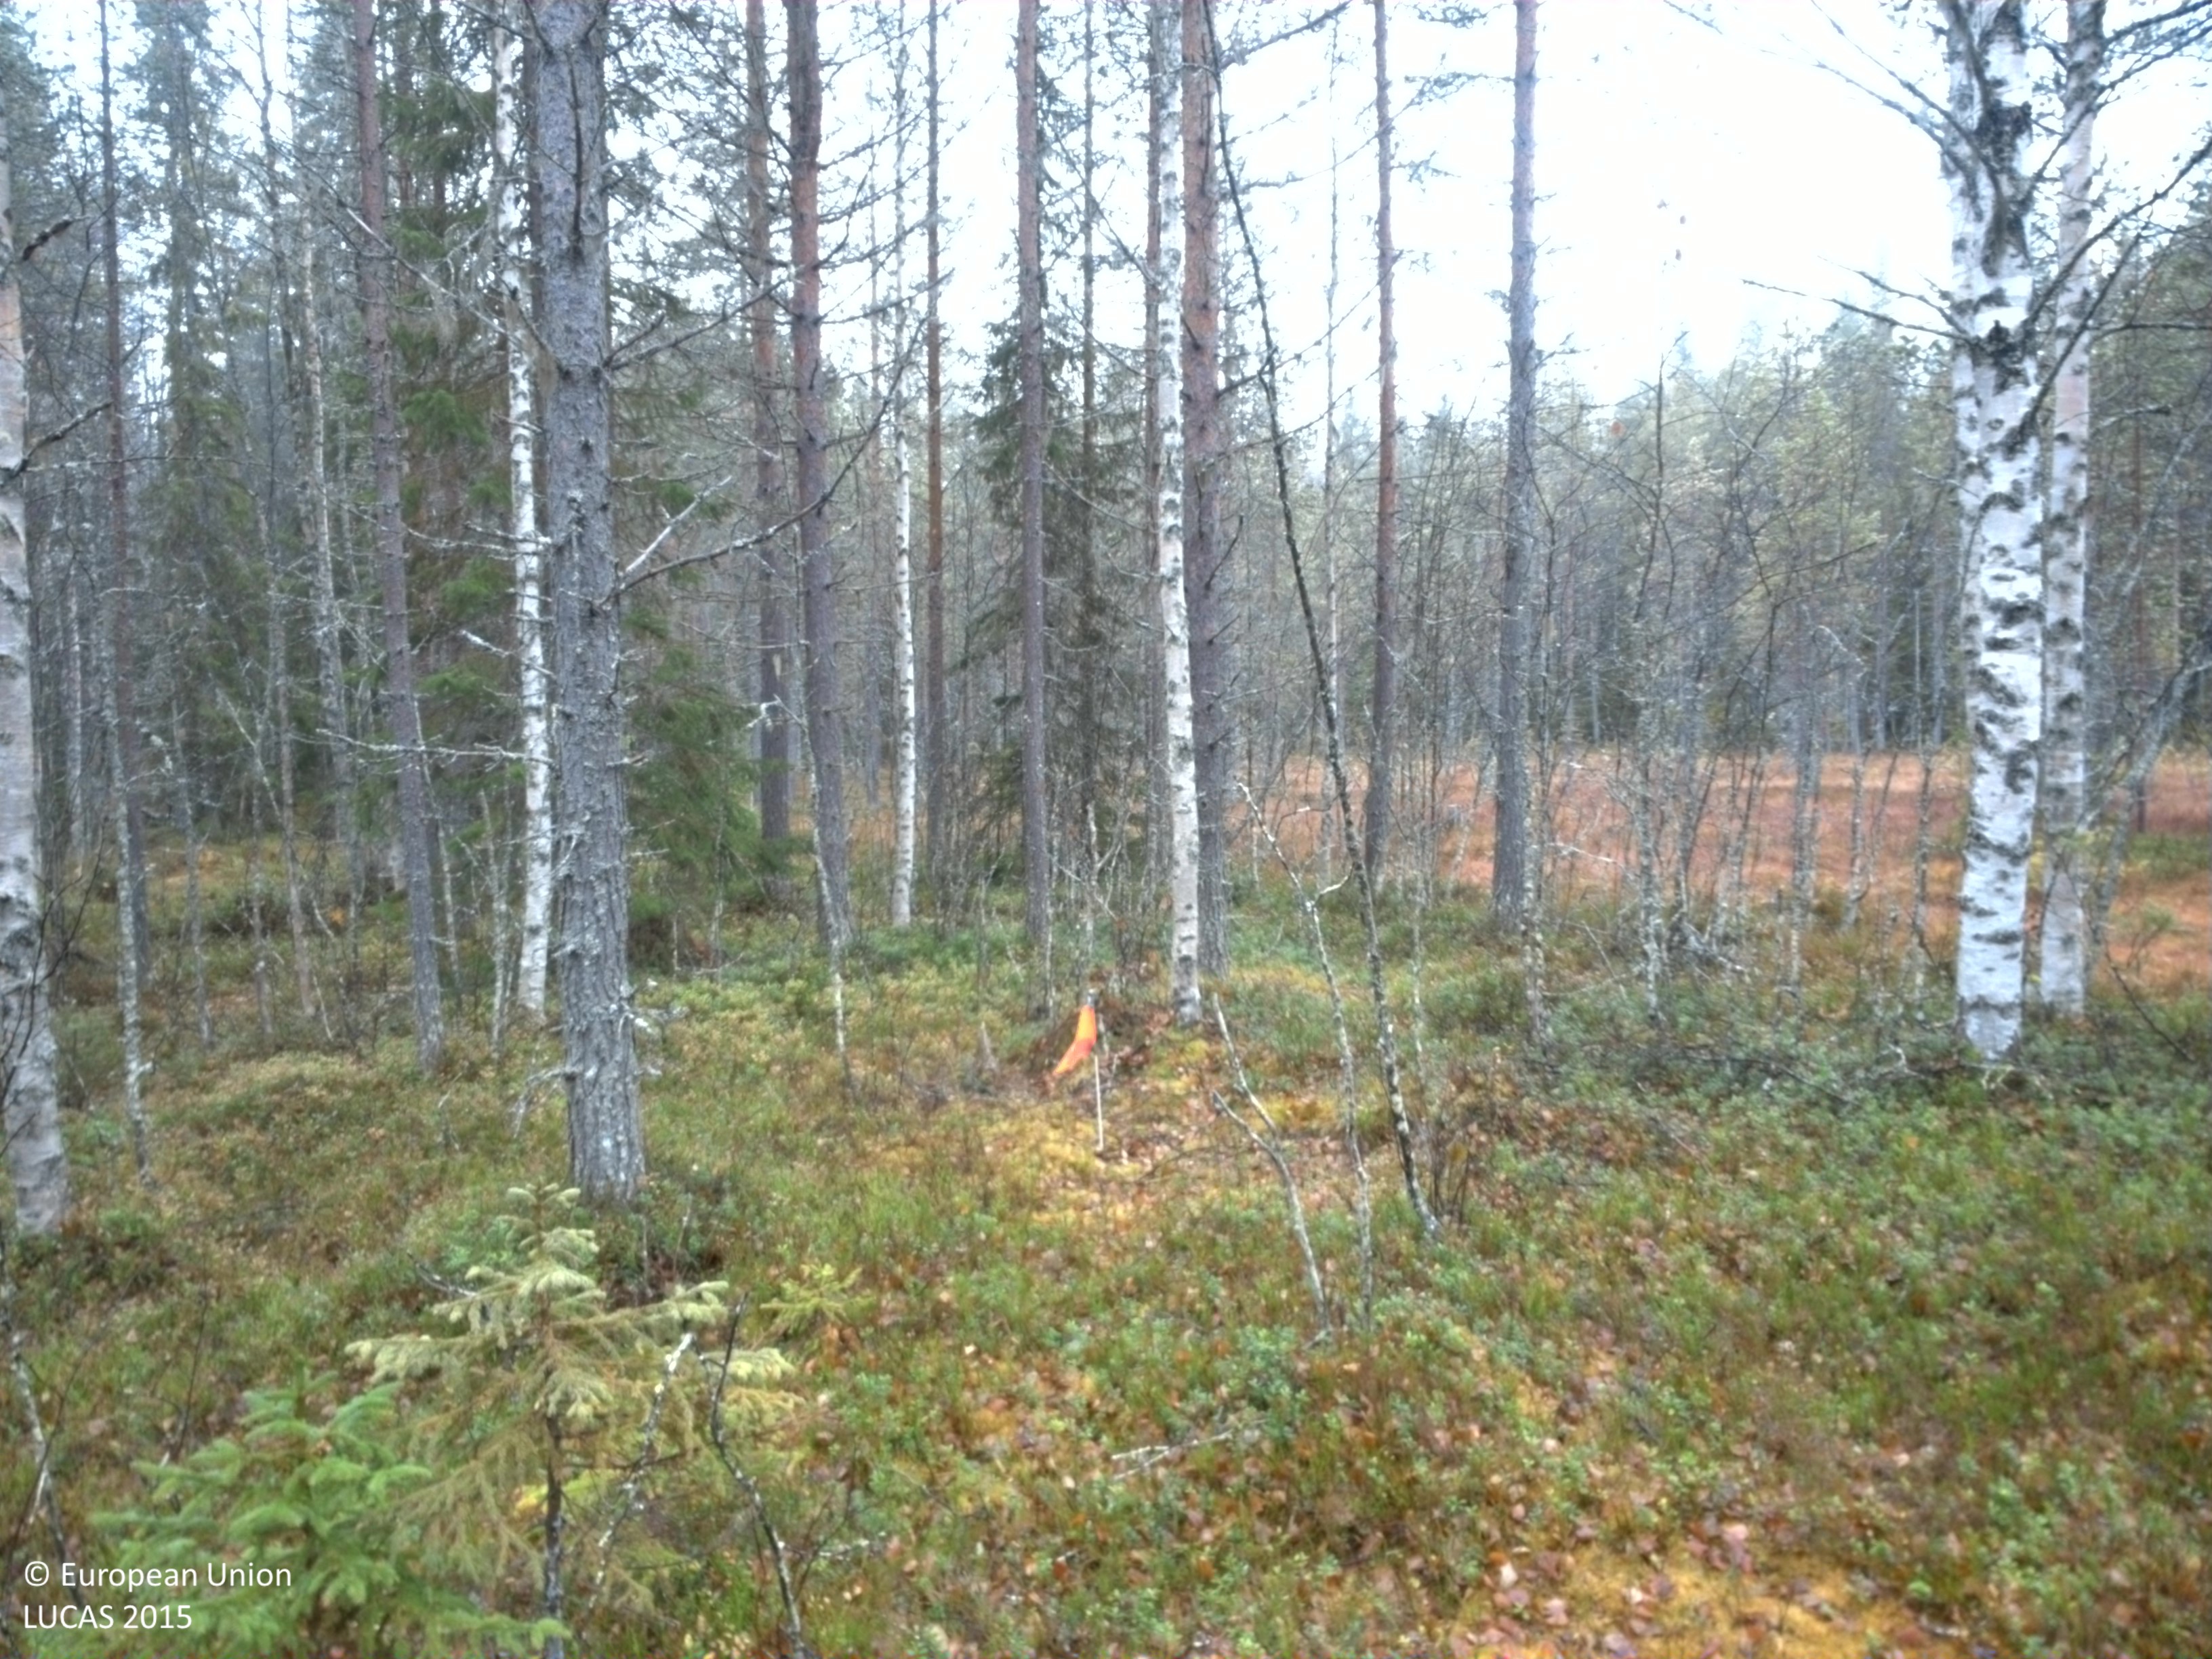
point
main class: Woodland
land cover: Pine dominated mixed woodland
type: boreal forest
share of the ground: 25 - 50 %
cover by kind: shrubs 35 %, coniferous forest trees 25 %, lichens and mosses 20 %, broadleaved forest trees 15 %, herbaceous plants 5 %
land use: Forestry
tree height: > 5 m
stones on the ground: < 10 %
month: October
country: SE
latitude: 64.4713
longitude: 16.7682
